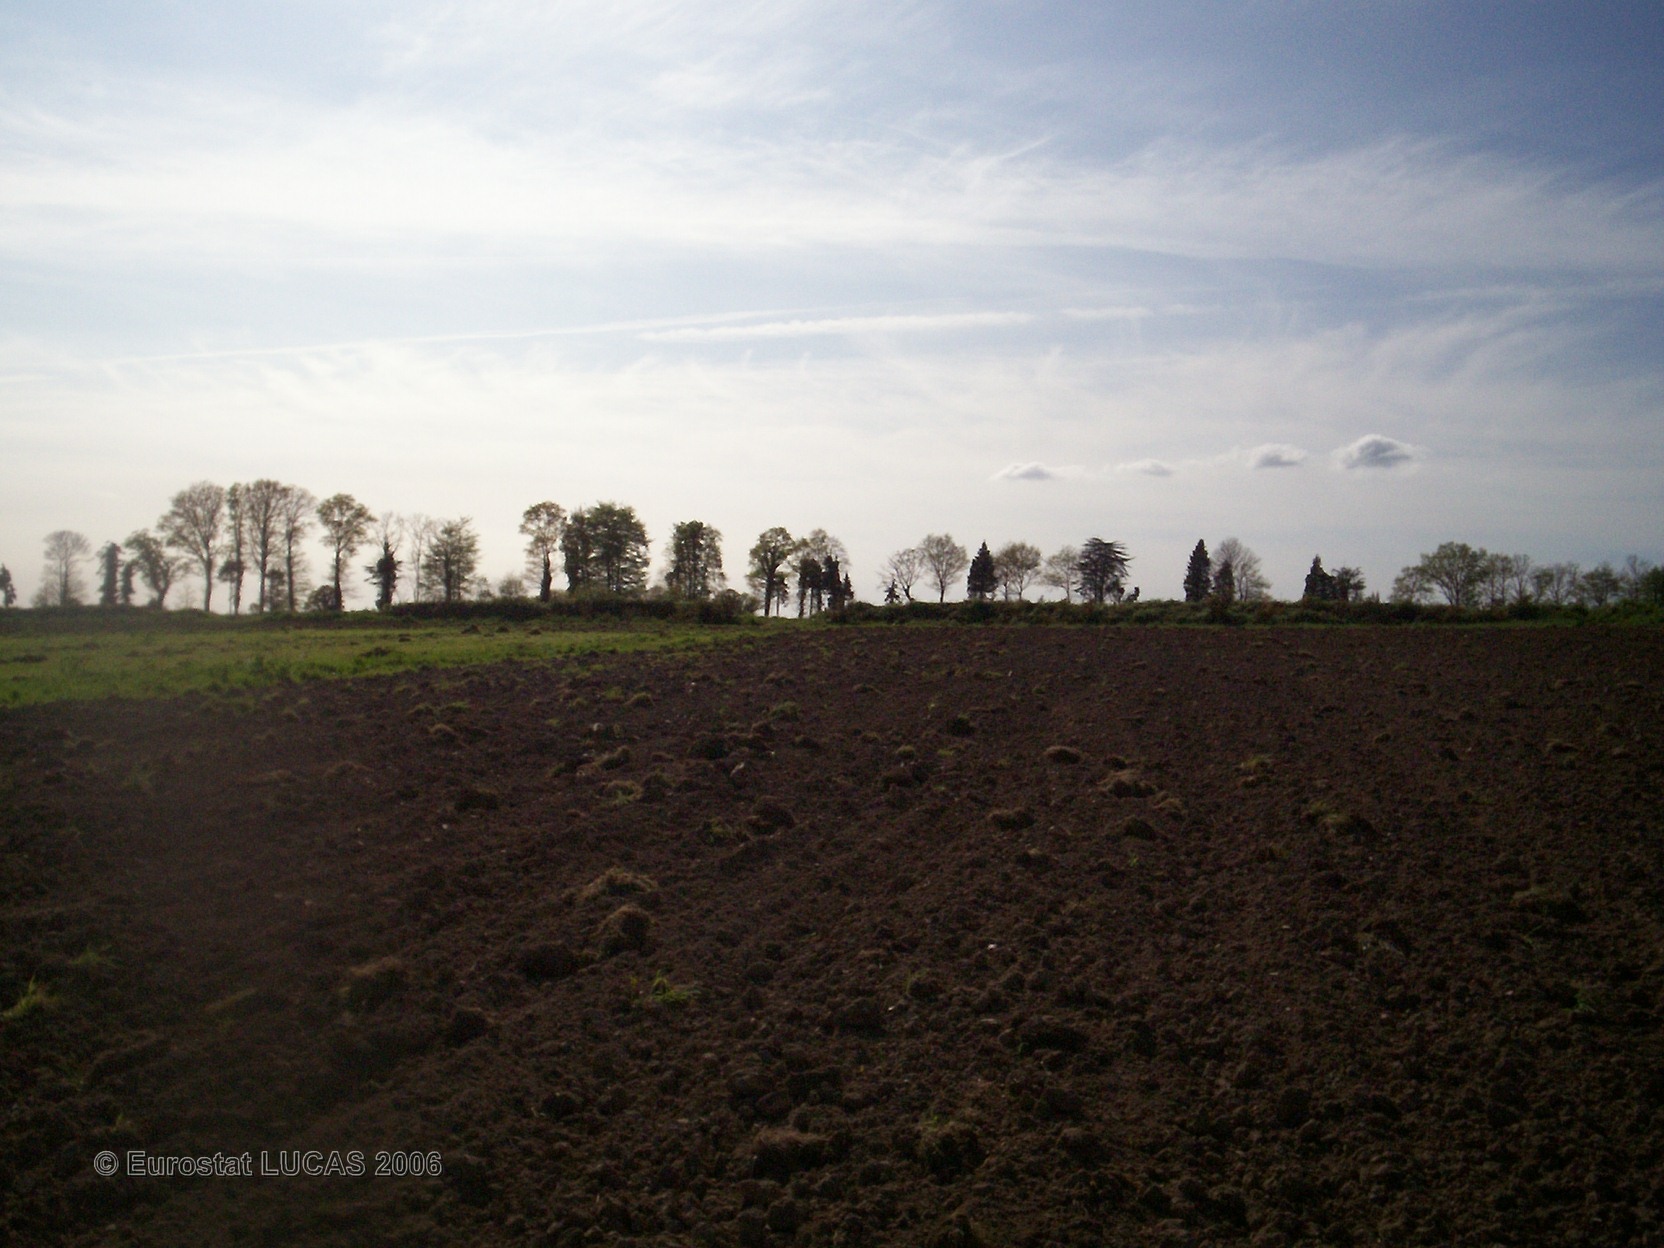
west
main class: Cropland
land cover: Maize
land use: Agriculture (excluding fallow land and kitchen gardens)
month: May
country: FR
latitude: 48.0059
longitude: -2.9210
